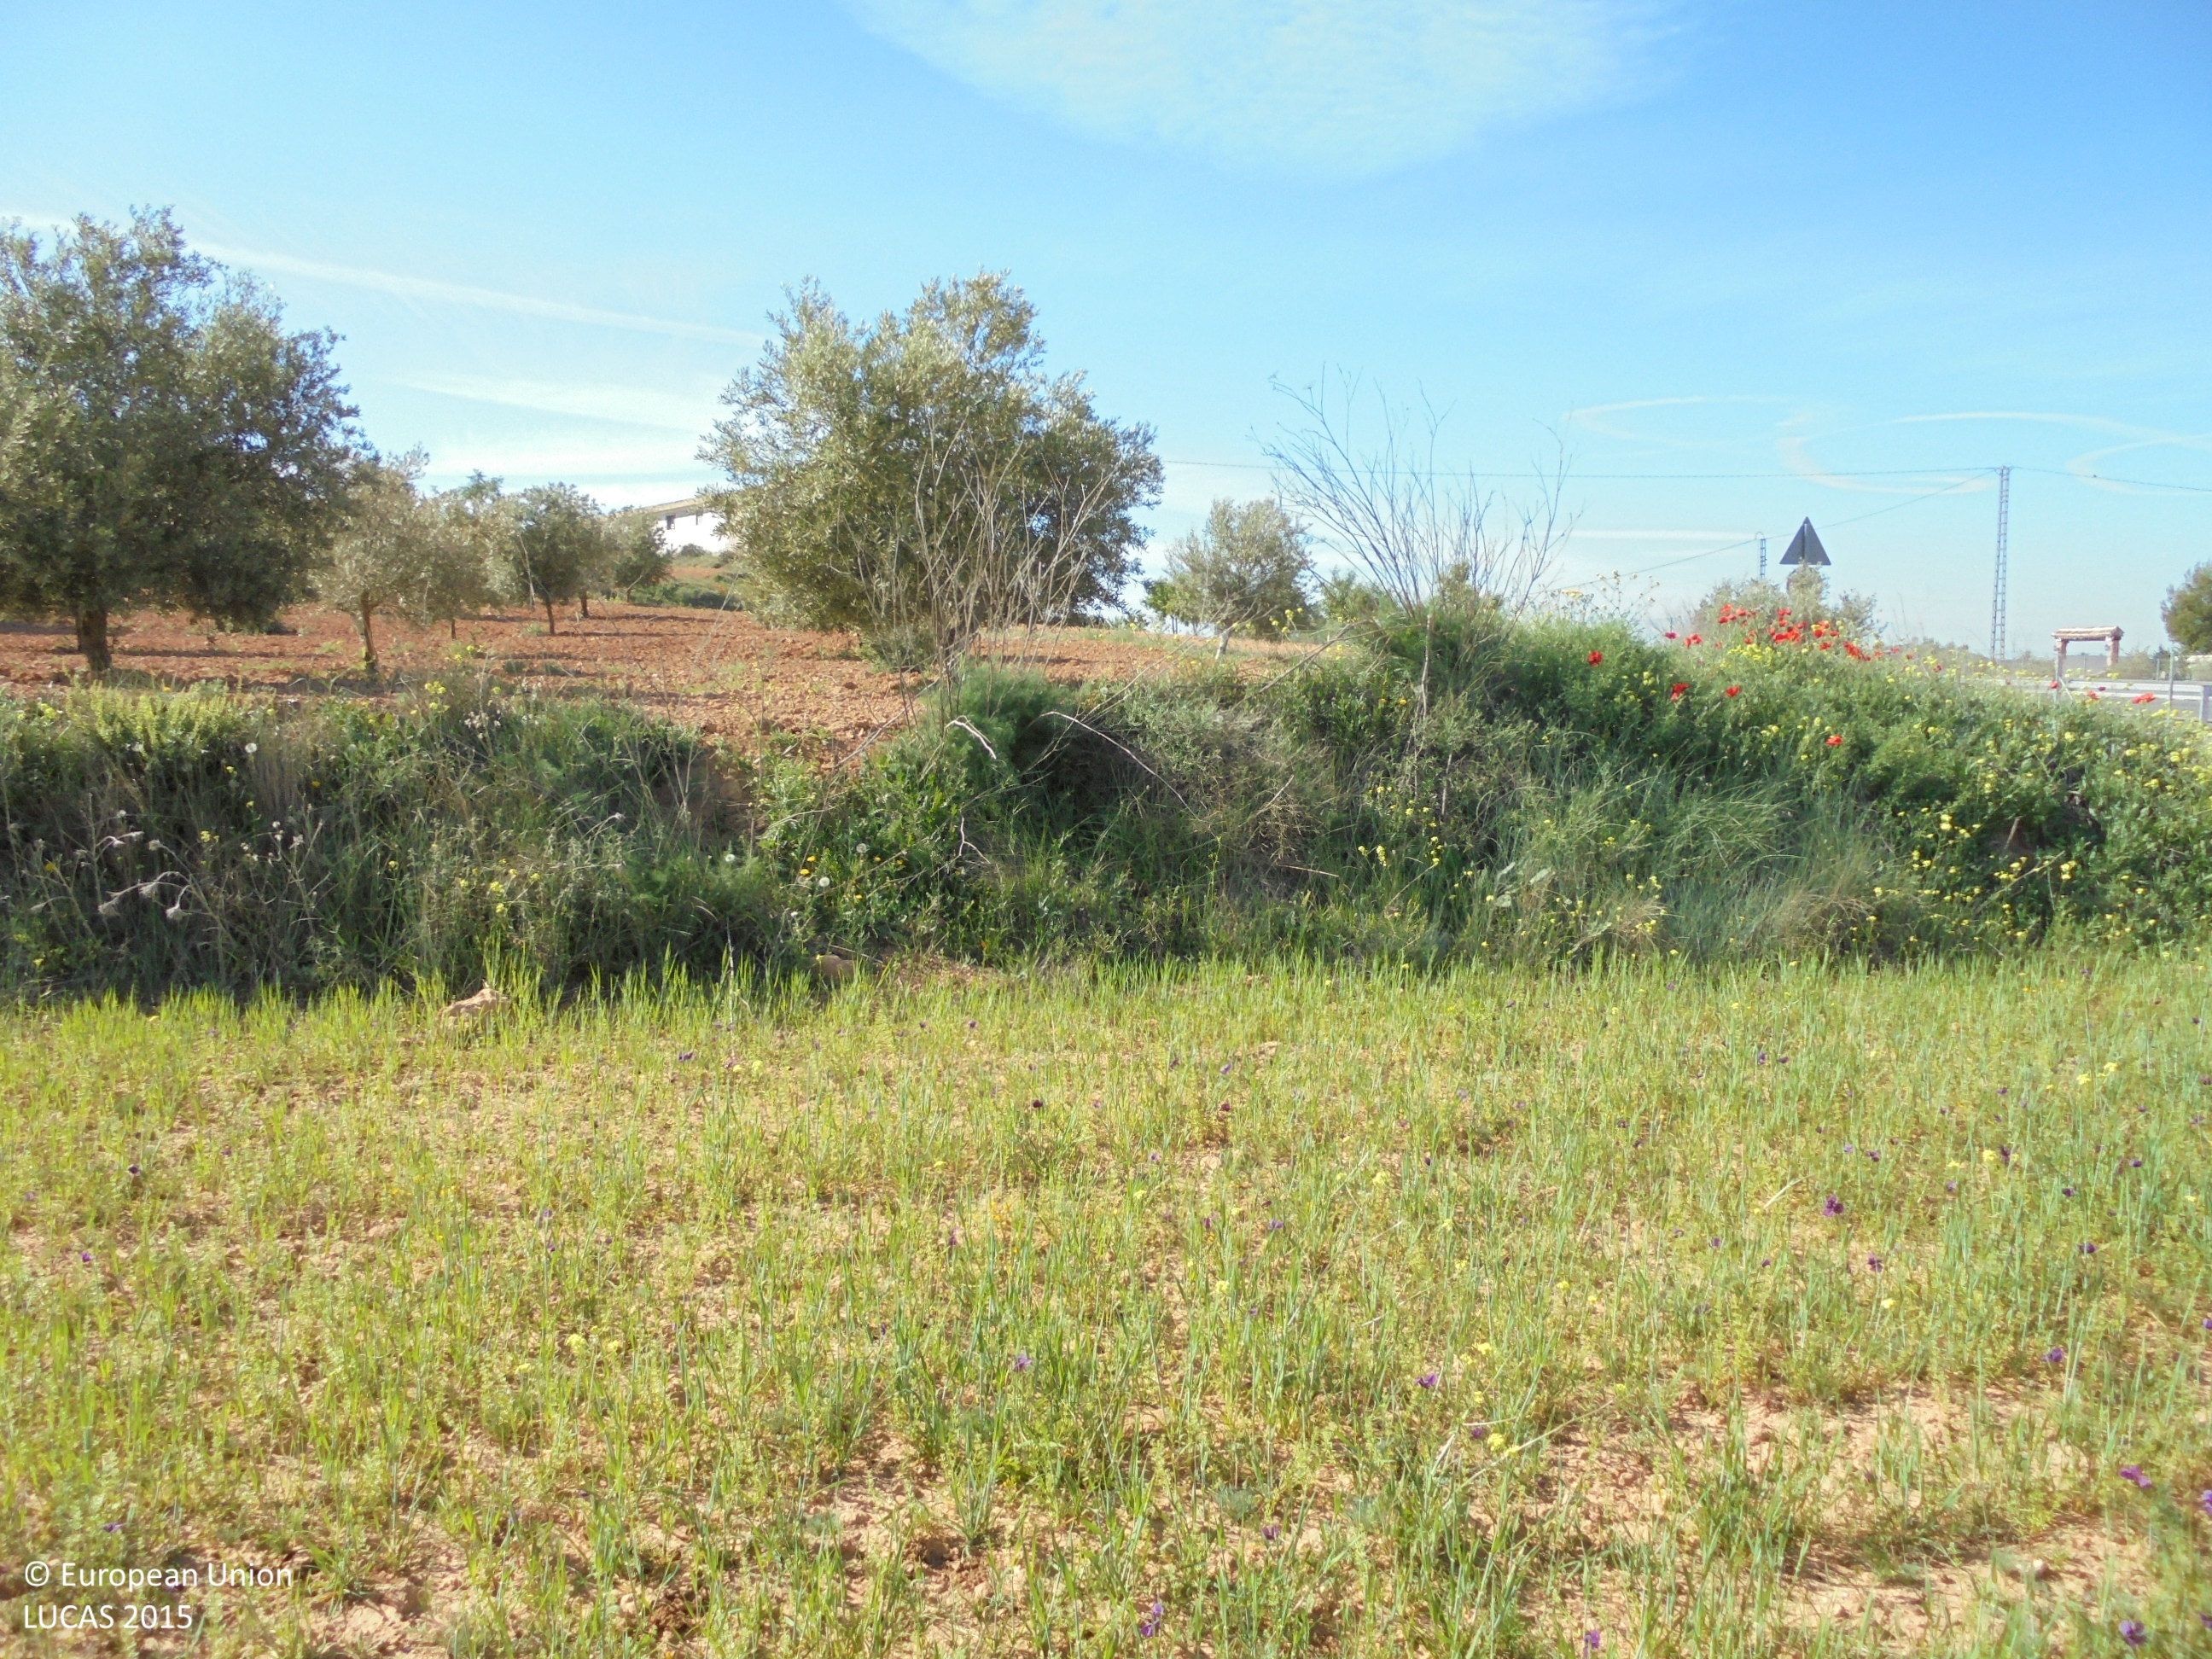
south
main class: Cropland
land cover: Barley
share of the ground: 25 - 50 %
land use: Agriculture (excluding fallow land and kitchen gardens)
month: May
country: ES
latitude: 39.2713
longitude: -1.5580
